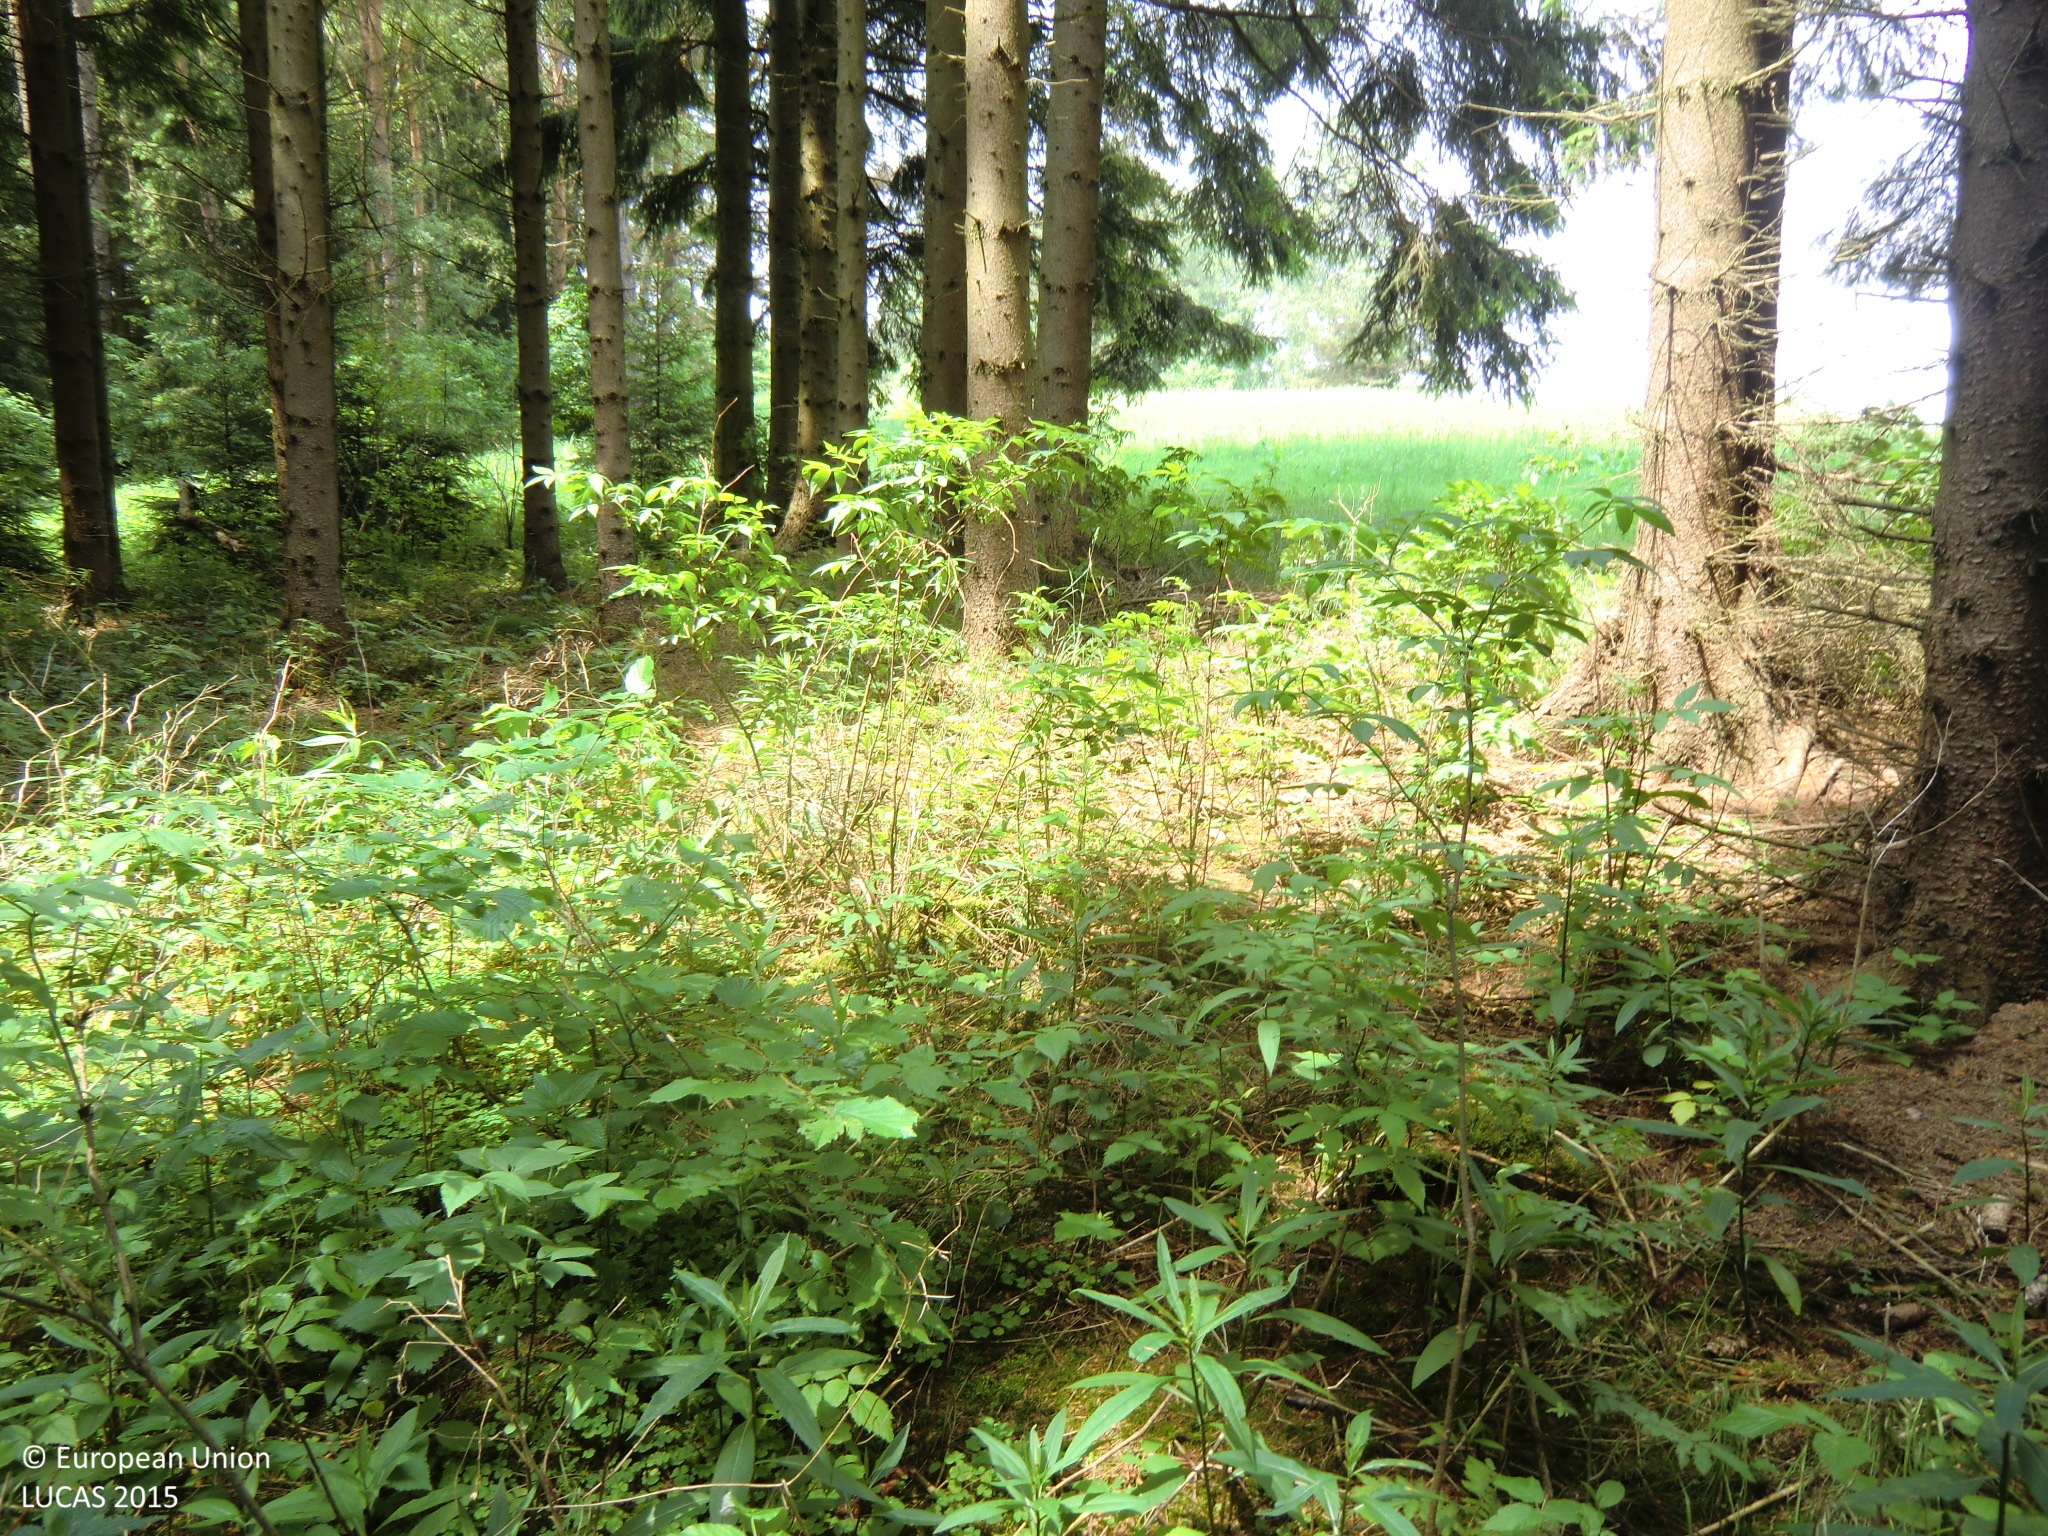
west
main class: Woodland
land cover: Spruce dominated coniferous woodland
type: hemiboreal forest and nemoral coniferous forest and mixed broadleaved-coniferous forest
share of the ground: > 75 %
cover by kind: coniferous forest trees 90 %, herbaceous plants 10 %
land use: Forestry
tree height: > 5 m
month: June
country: AT
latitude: 48.6206
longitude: 14.8717
